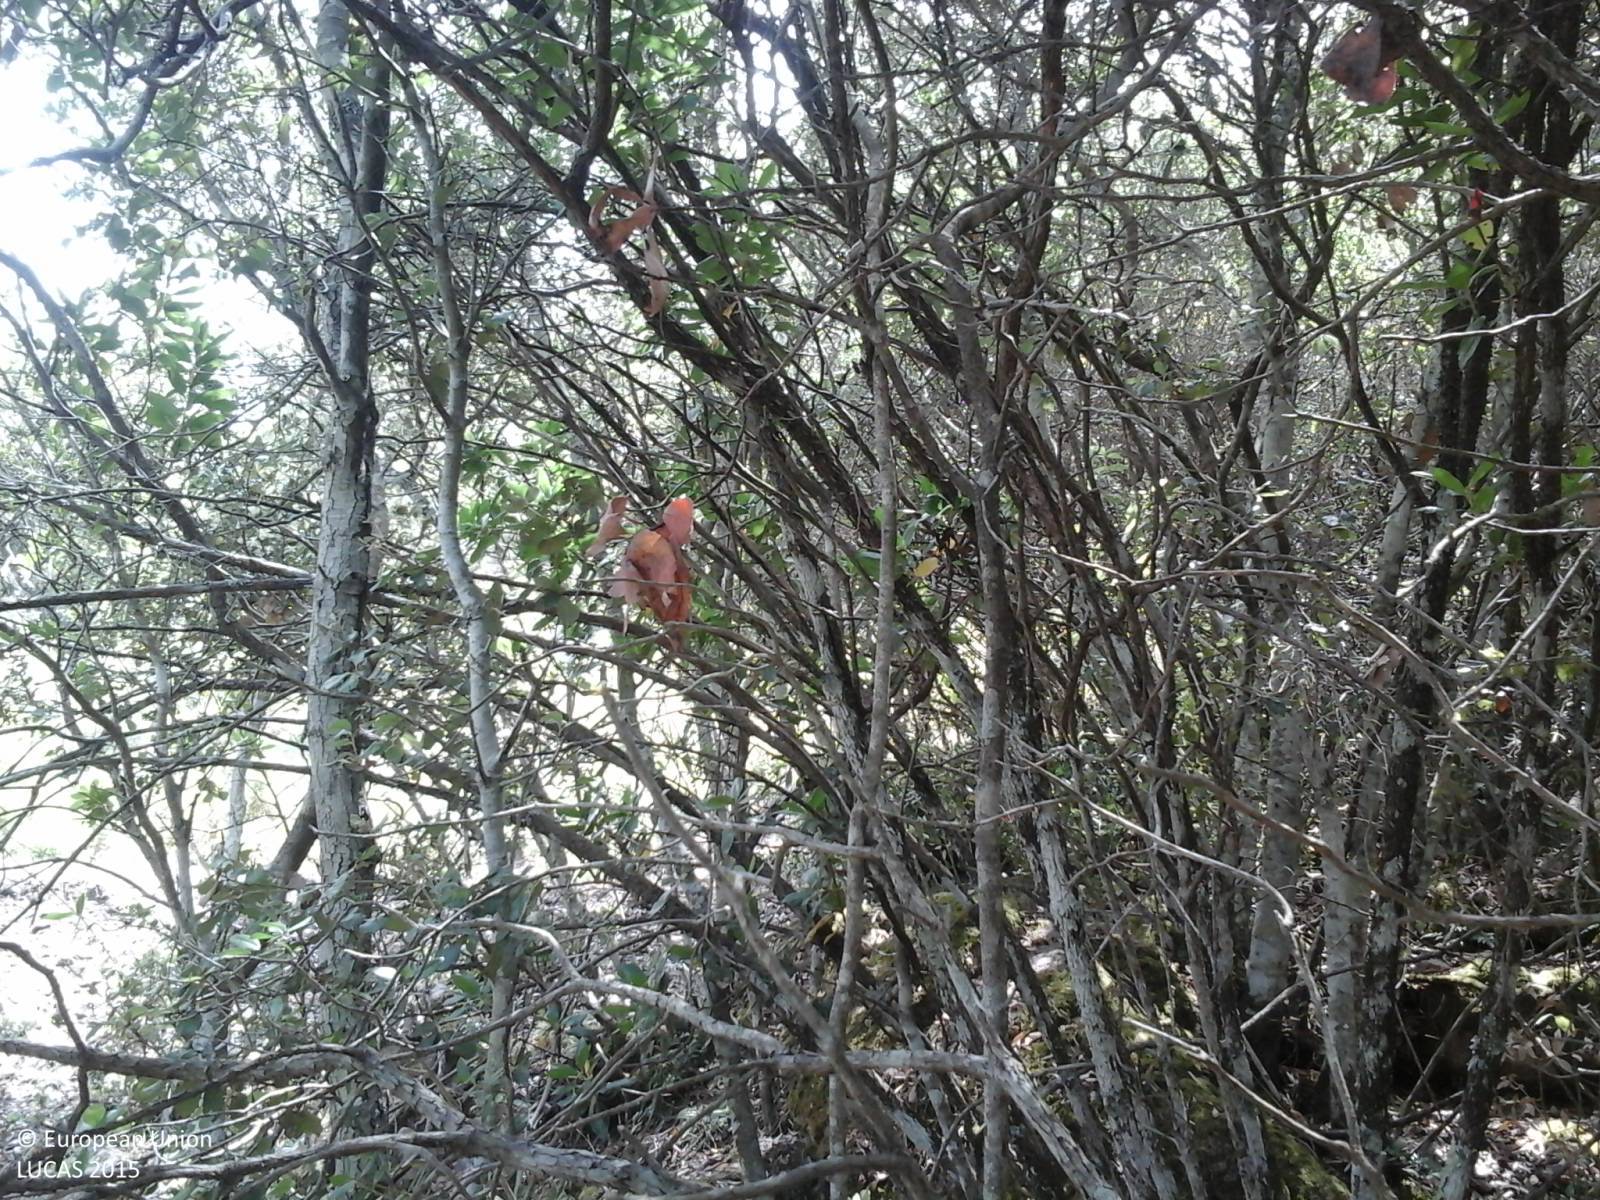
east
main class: Woodland
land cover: Broadleaved woodland
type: broadleaved evergreen forest
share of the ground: > 75 %
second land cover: Grassland without tree/shrub cover
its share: > 75 %
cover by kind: broadleaved forest trees 75 %, herbaceous plants 25 %
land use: Forestry
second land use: Agriculture (excluding fallow land and kitchen gardens)
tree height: > 5 m
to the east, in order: Broadleaved woodland; Grassland without tree/shrub cover; Fences; Broadleaved woodland; Tracks; Broadleaved woodland; Shrubland with sparse tree cover; Tracks; Broadleaved woodland
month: June
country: IT
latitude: 40.6820
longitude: 9.4466
